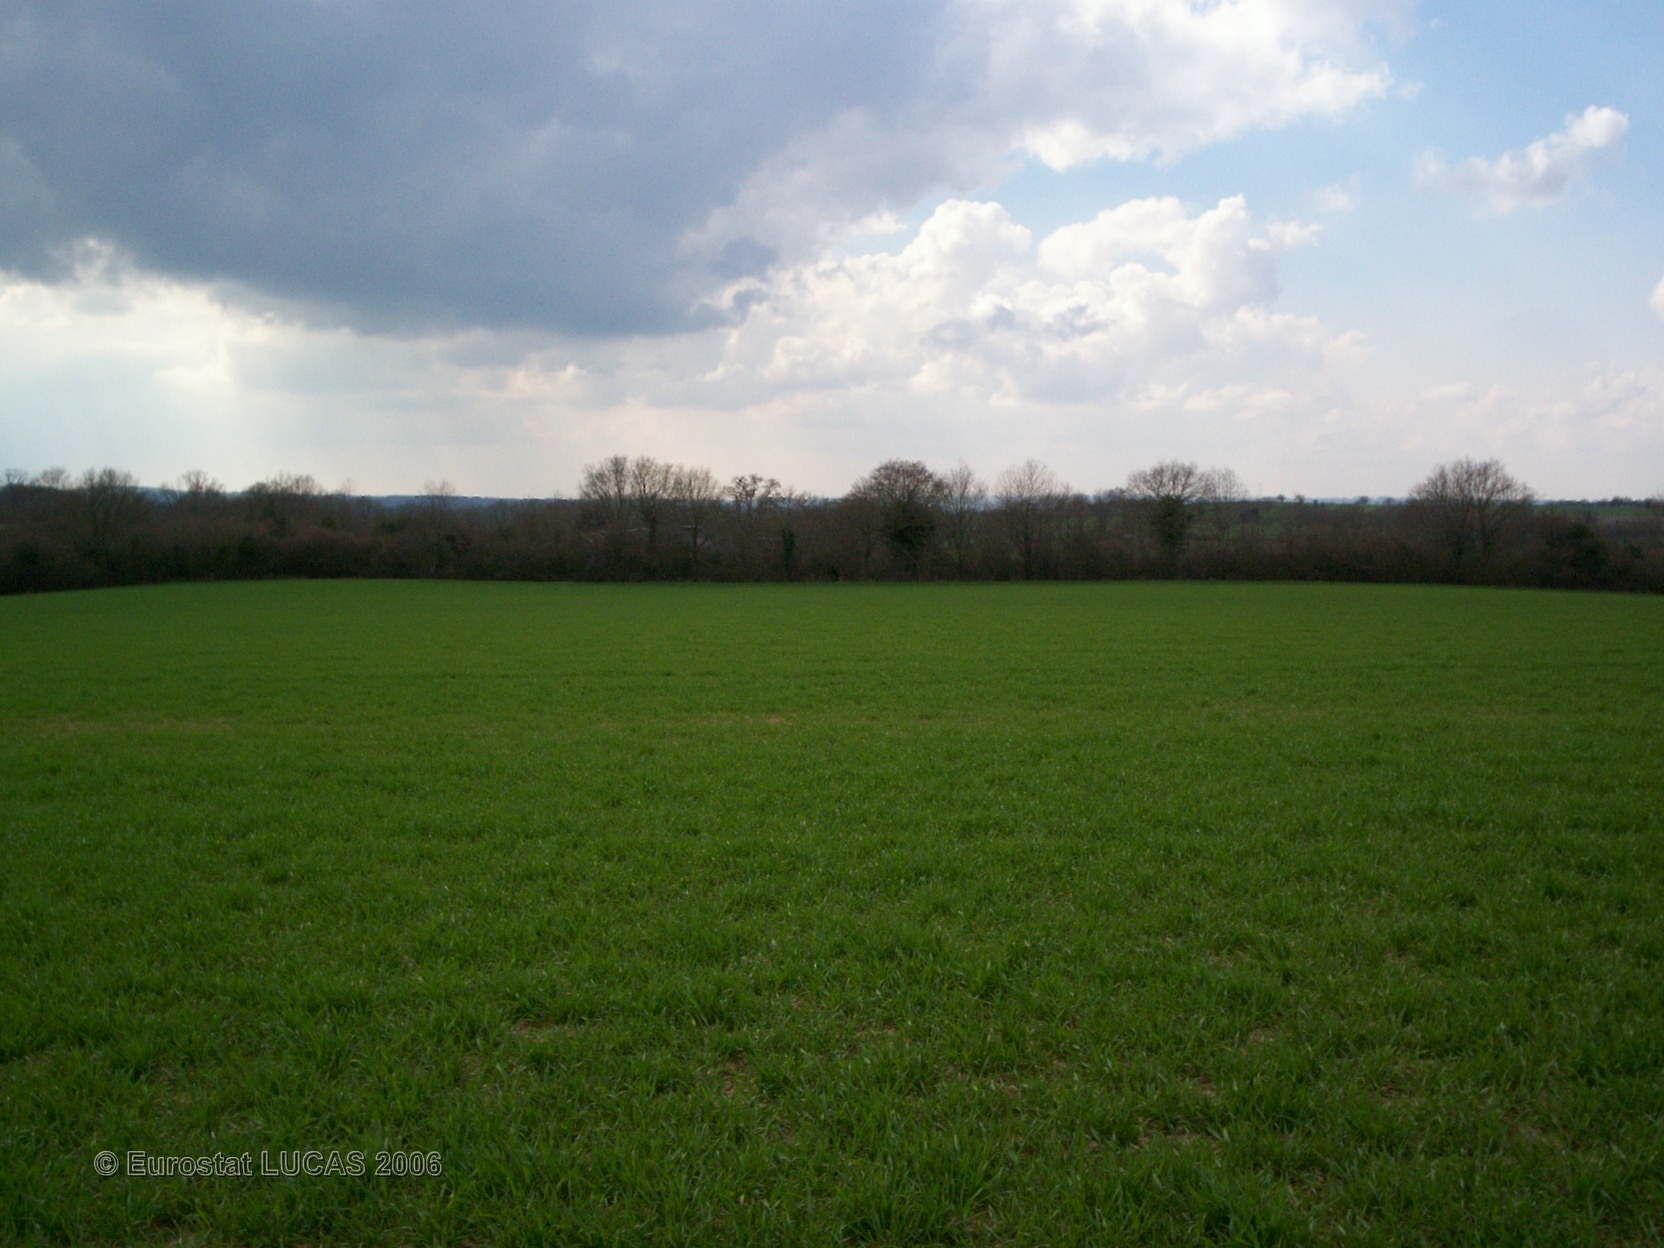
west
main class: Cropland
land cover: Common wheat
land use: Agriculture (excluding fallow land and kitchen gardens)
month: April
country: FR
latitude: 48.3944
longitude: -0.2830
